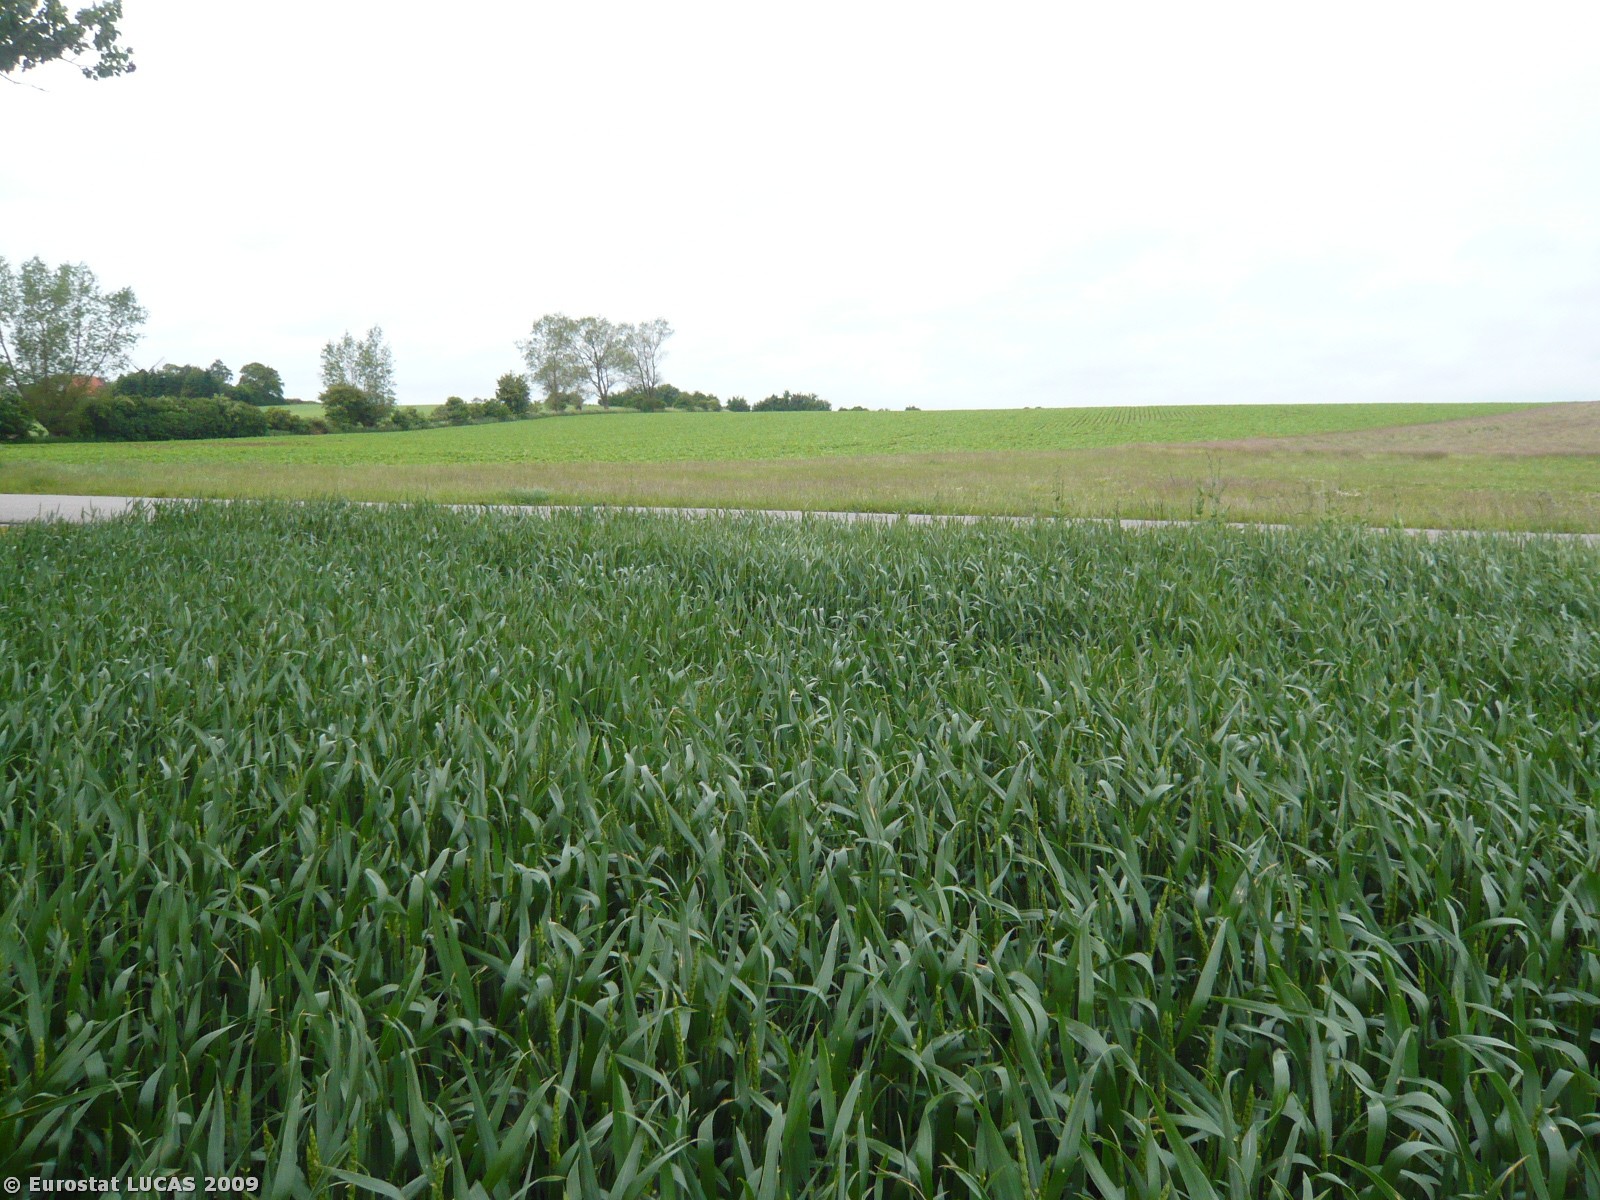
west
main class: Cropland
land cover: Common wheat
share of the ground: > 75 %
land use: Agriculture (excluding fallow land and kitchen gardens)
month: June
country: DK
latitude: 54.7168
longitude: 11.9393
